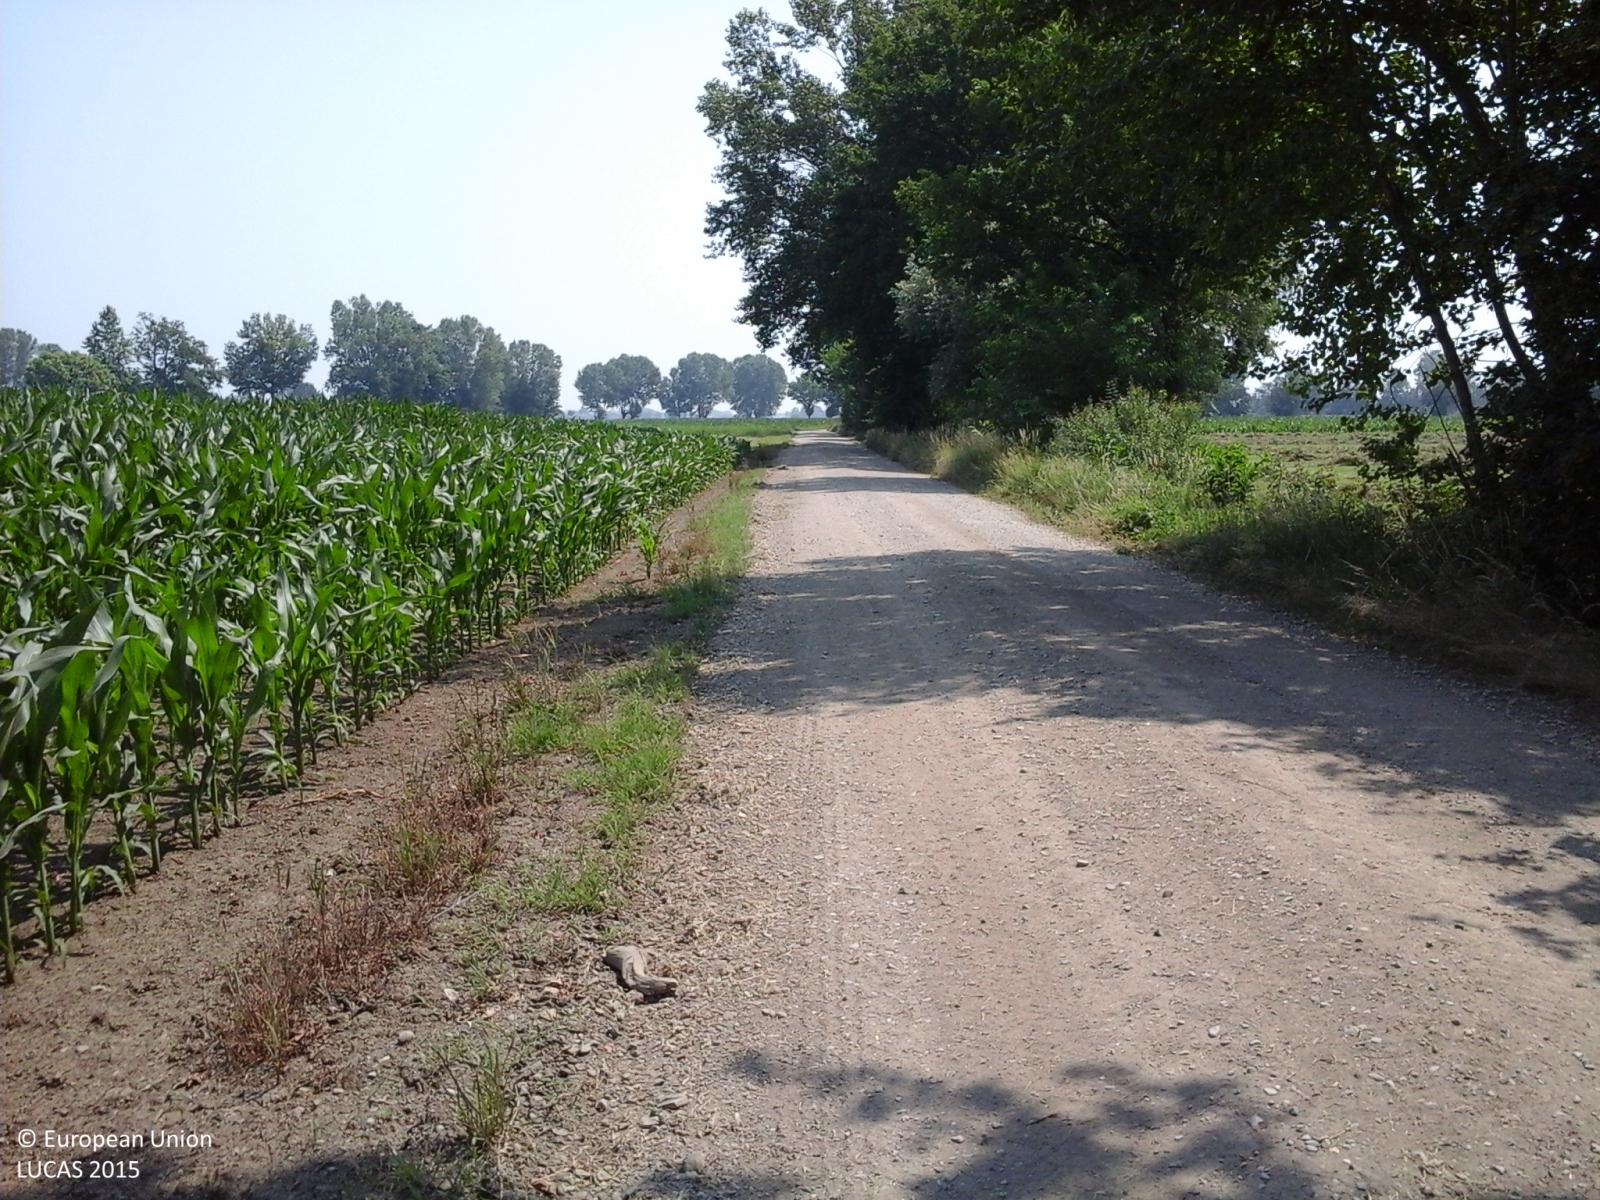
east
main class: Cropland
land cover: Maize
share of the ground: > 75 %
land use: Agriculture (excluding fallow land and kitchen gardens)
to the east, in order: Maize; Ditches and canals; Lucerne; Ditches and canals; Maize
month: June
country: IT
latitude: 44.9996
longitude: 10.1646
